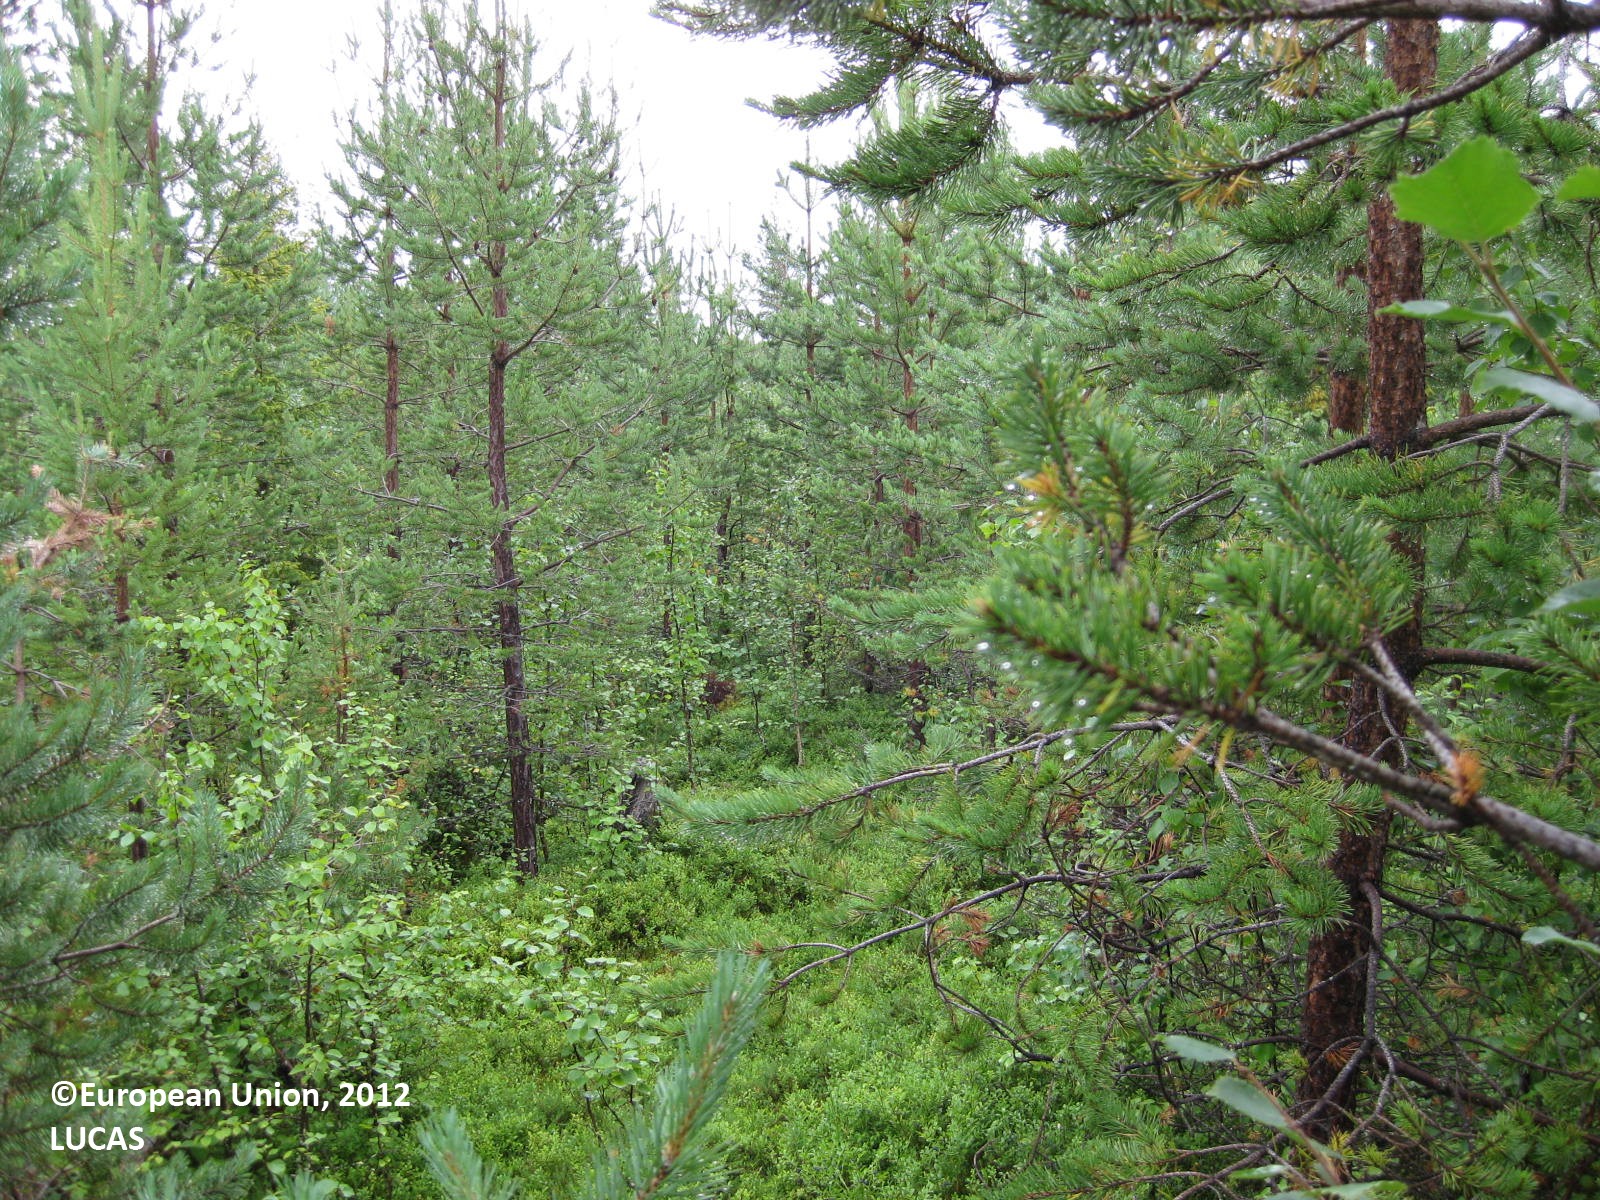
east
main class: Woodland
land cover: Pine dominated mixed woodland
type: boreal forest
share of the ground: > 75 %
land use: Forestry
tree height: > 5 m
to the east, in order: Pine dominated mixed woodland; Ditches and canals; Pine dominated mixed woodland; Ditches and canals; Pine dominated mixed woodland; Ditches and canals; Pine dominated coniferous woodland; Ditches and canals; Pine dominated coniferous woodland; Ditches and canals; Pine dominated coniferous woodland; Ditches and canals; Pine dominated coniferous woodland; Ditches and canals; Pine dominated coniferous woodland; Ditches and canals; Pine dominated coniferous woodland; Ditches and canals; Pine dominated coniferous woodland; Ditches and canals; Pine dominated coniferous woodland; Ponds and wetlands; Pine dominated coniferous woodland; Ponds and wetlands; Pine dominated coniferous woodland; Peatbogs
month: August
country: FI
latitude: 66.0940
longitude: 28.2104
